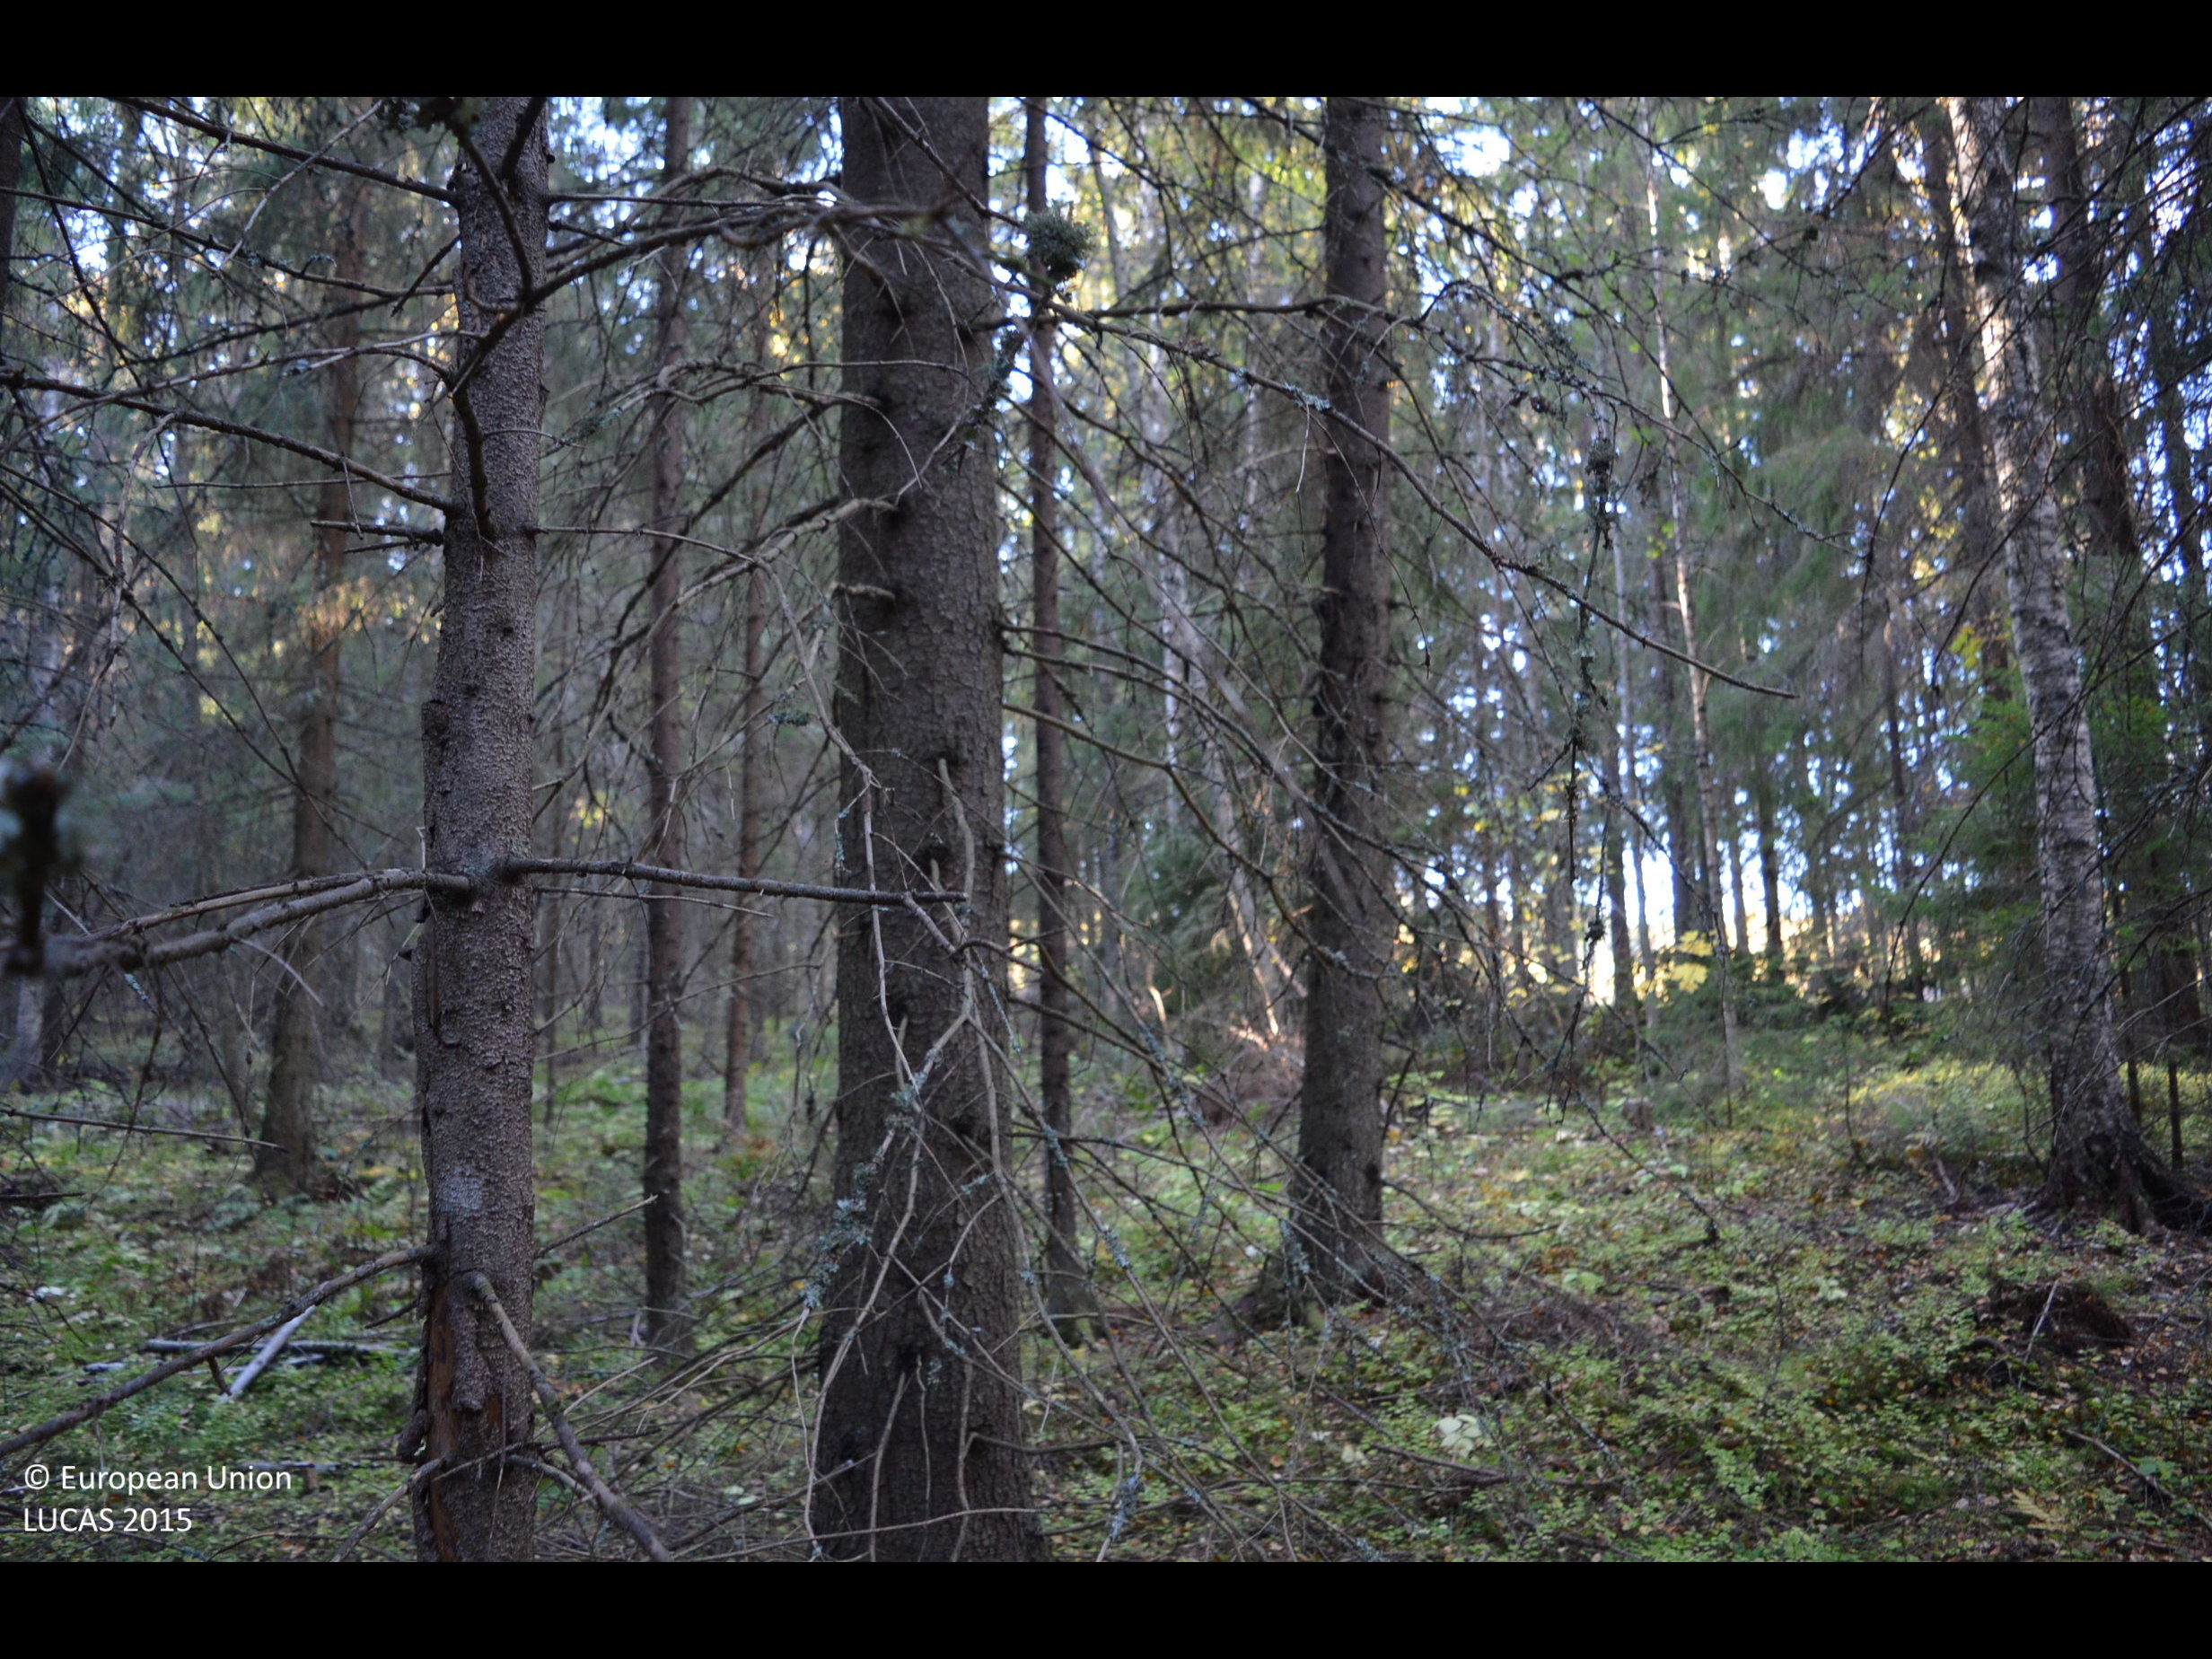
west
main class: Woodland
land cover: Spruce dominated coniferous woodland
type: boreal forest
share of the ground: > 75 %
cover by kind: coniferous forest trees 65 %, broadleaved forest trees 10 %, shrubs 10 %, lichens and mosses 10 %, herbaceous plants 5 %
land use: Forestry
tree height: > 5 m
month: October
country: FI
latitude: 61.5777
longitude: 23.3157
